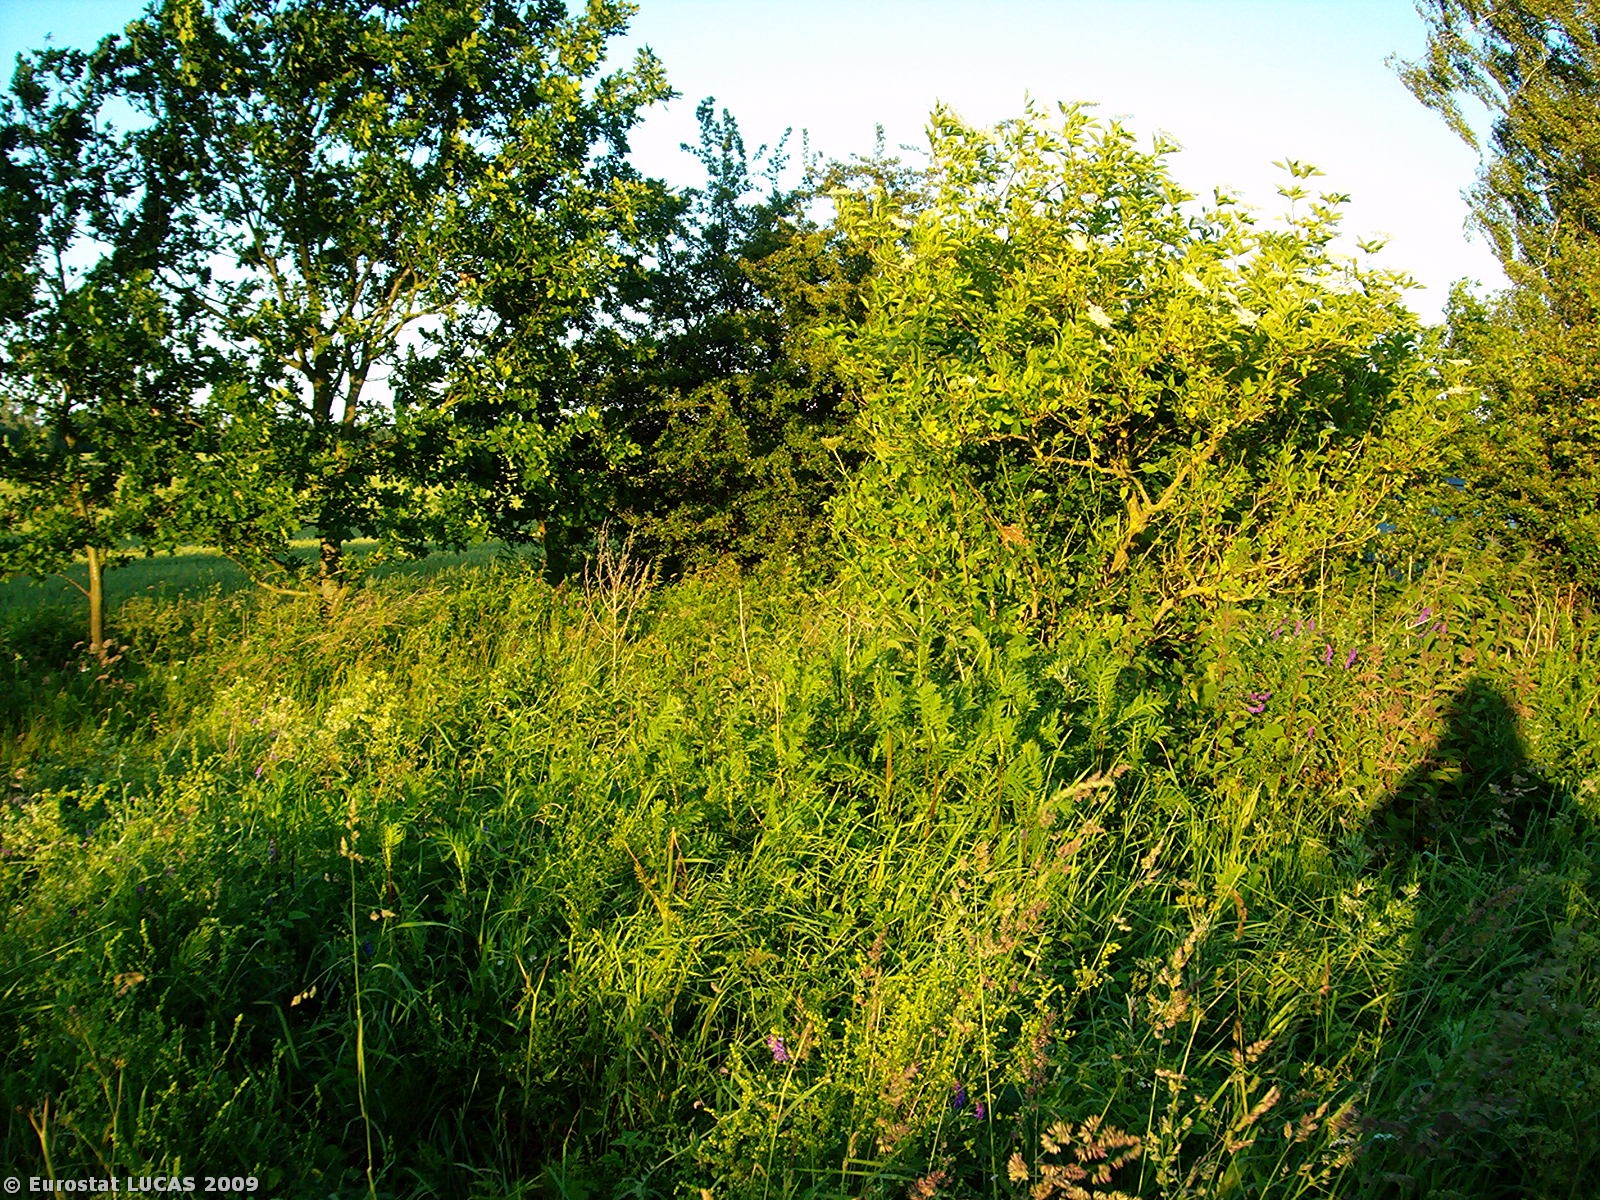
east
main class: Cropland
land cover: Rape and turnip rape
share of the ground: > 75 %
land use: Agriculture (excluding fallow land and kitchen gardens)
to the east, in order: Rape and turnip rape
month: June
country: PL
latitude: 53.7107
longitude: 15.4725
